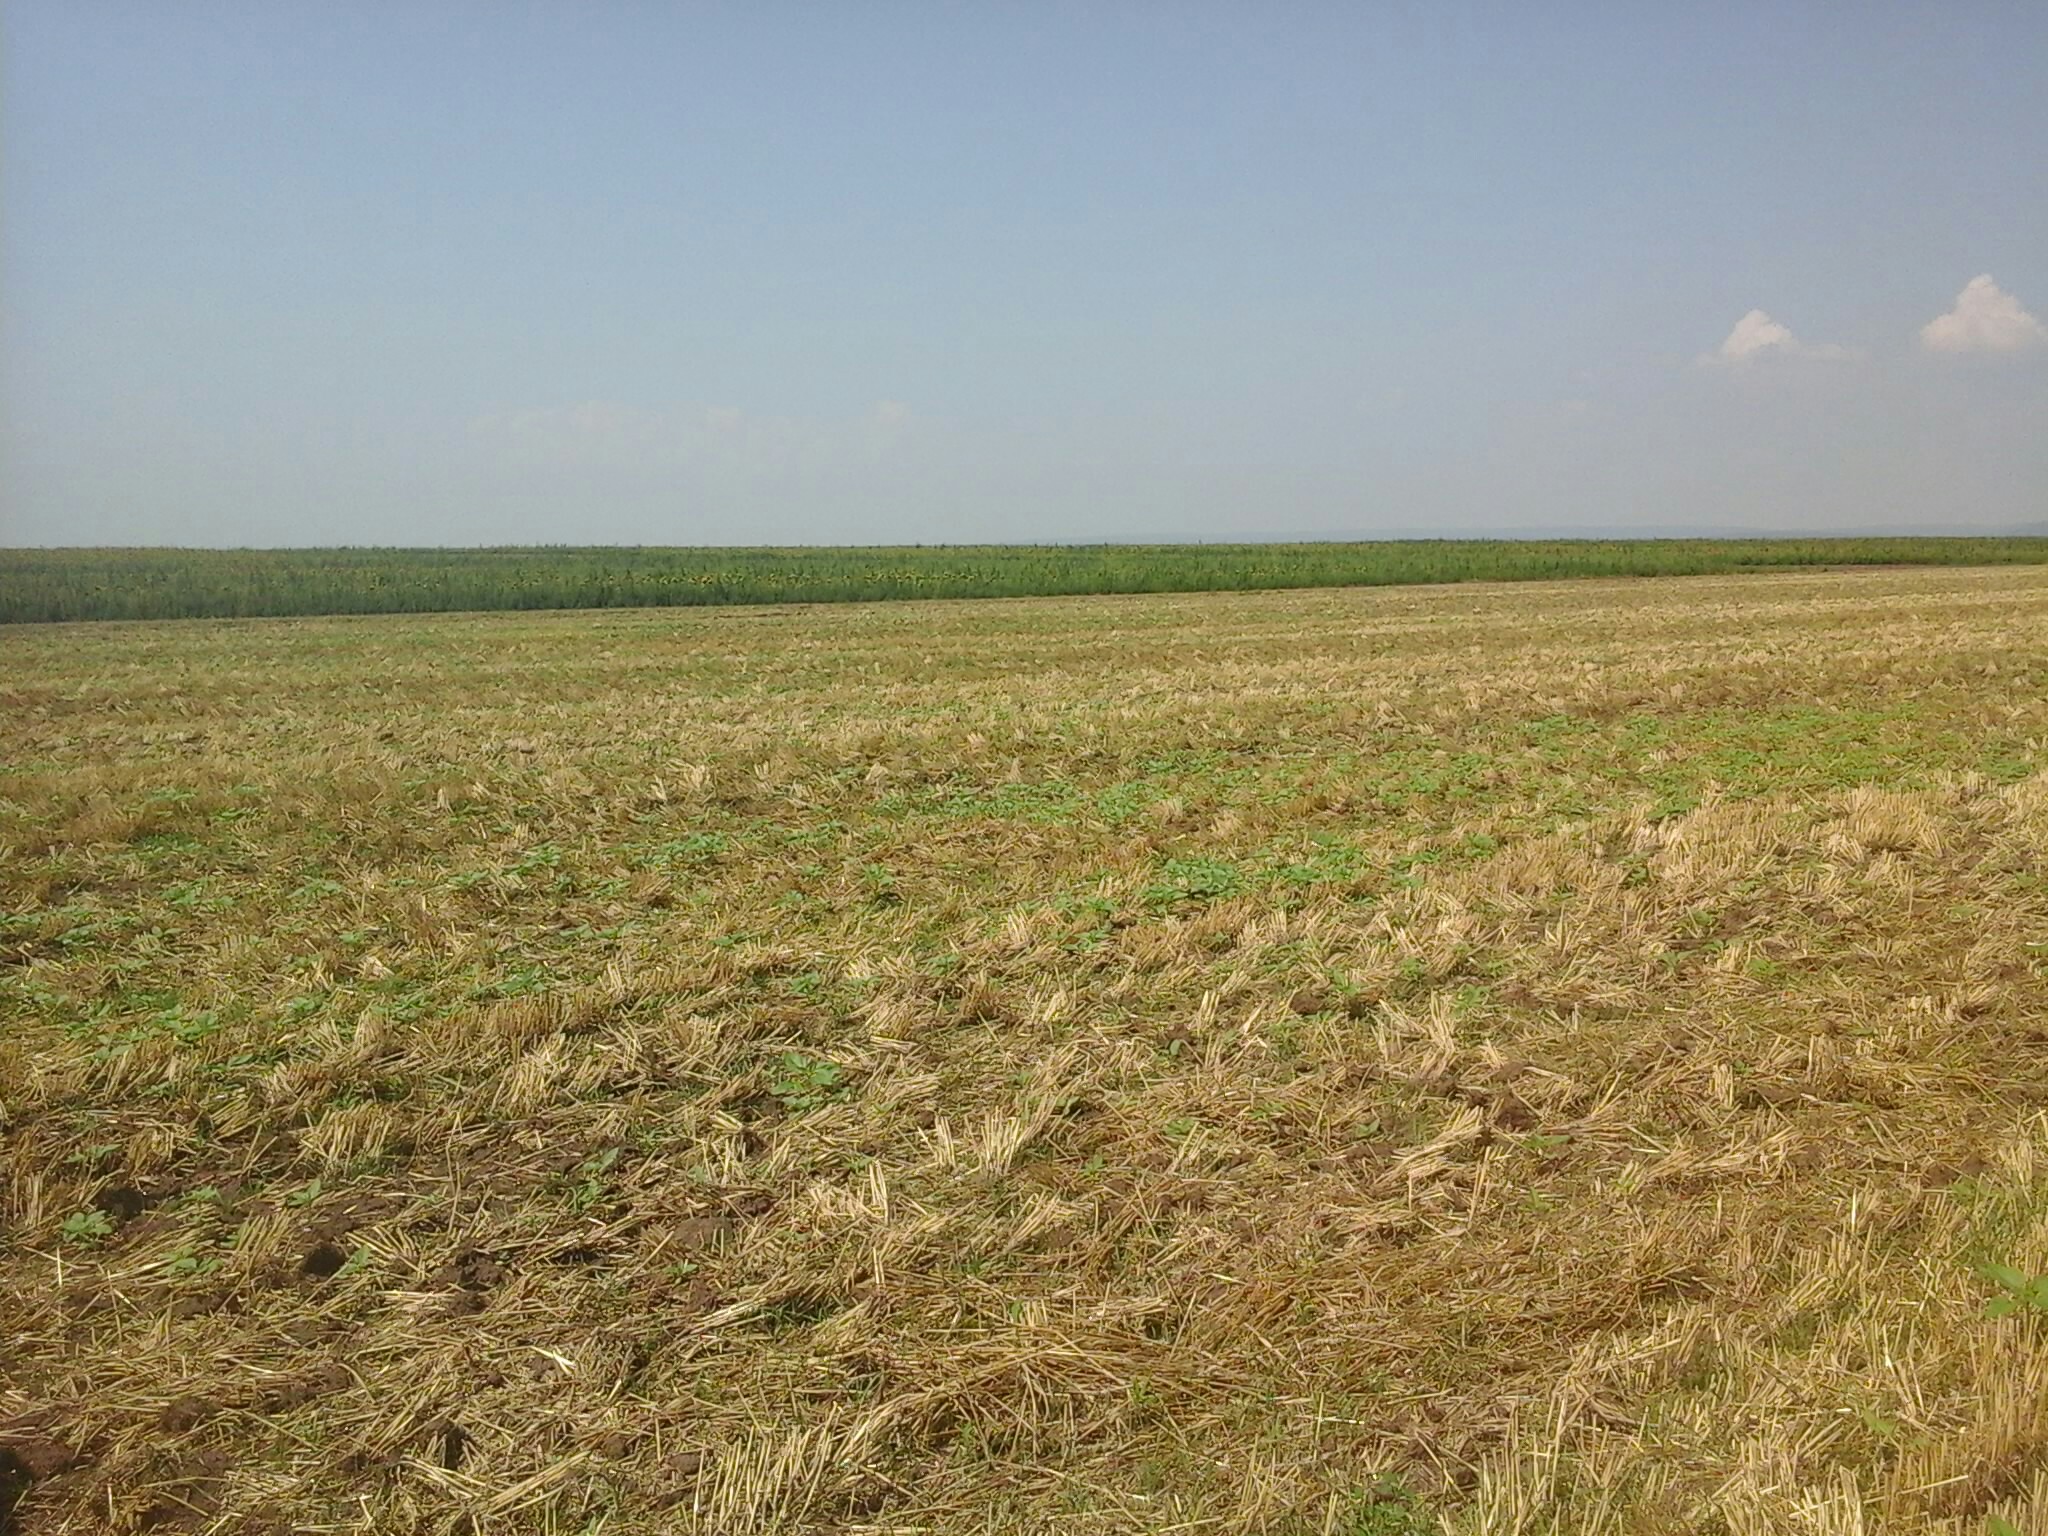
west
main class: Cropland
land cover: Common wheat
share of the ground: < 10 %
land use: Agriculture (excluding fallow land and kitchen gardens)
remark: Harvested field
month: August
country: HU
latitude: 47.3479
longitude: 18.5516
